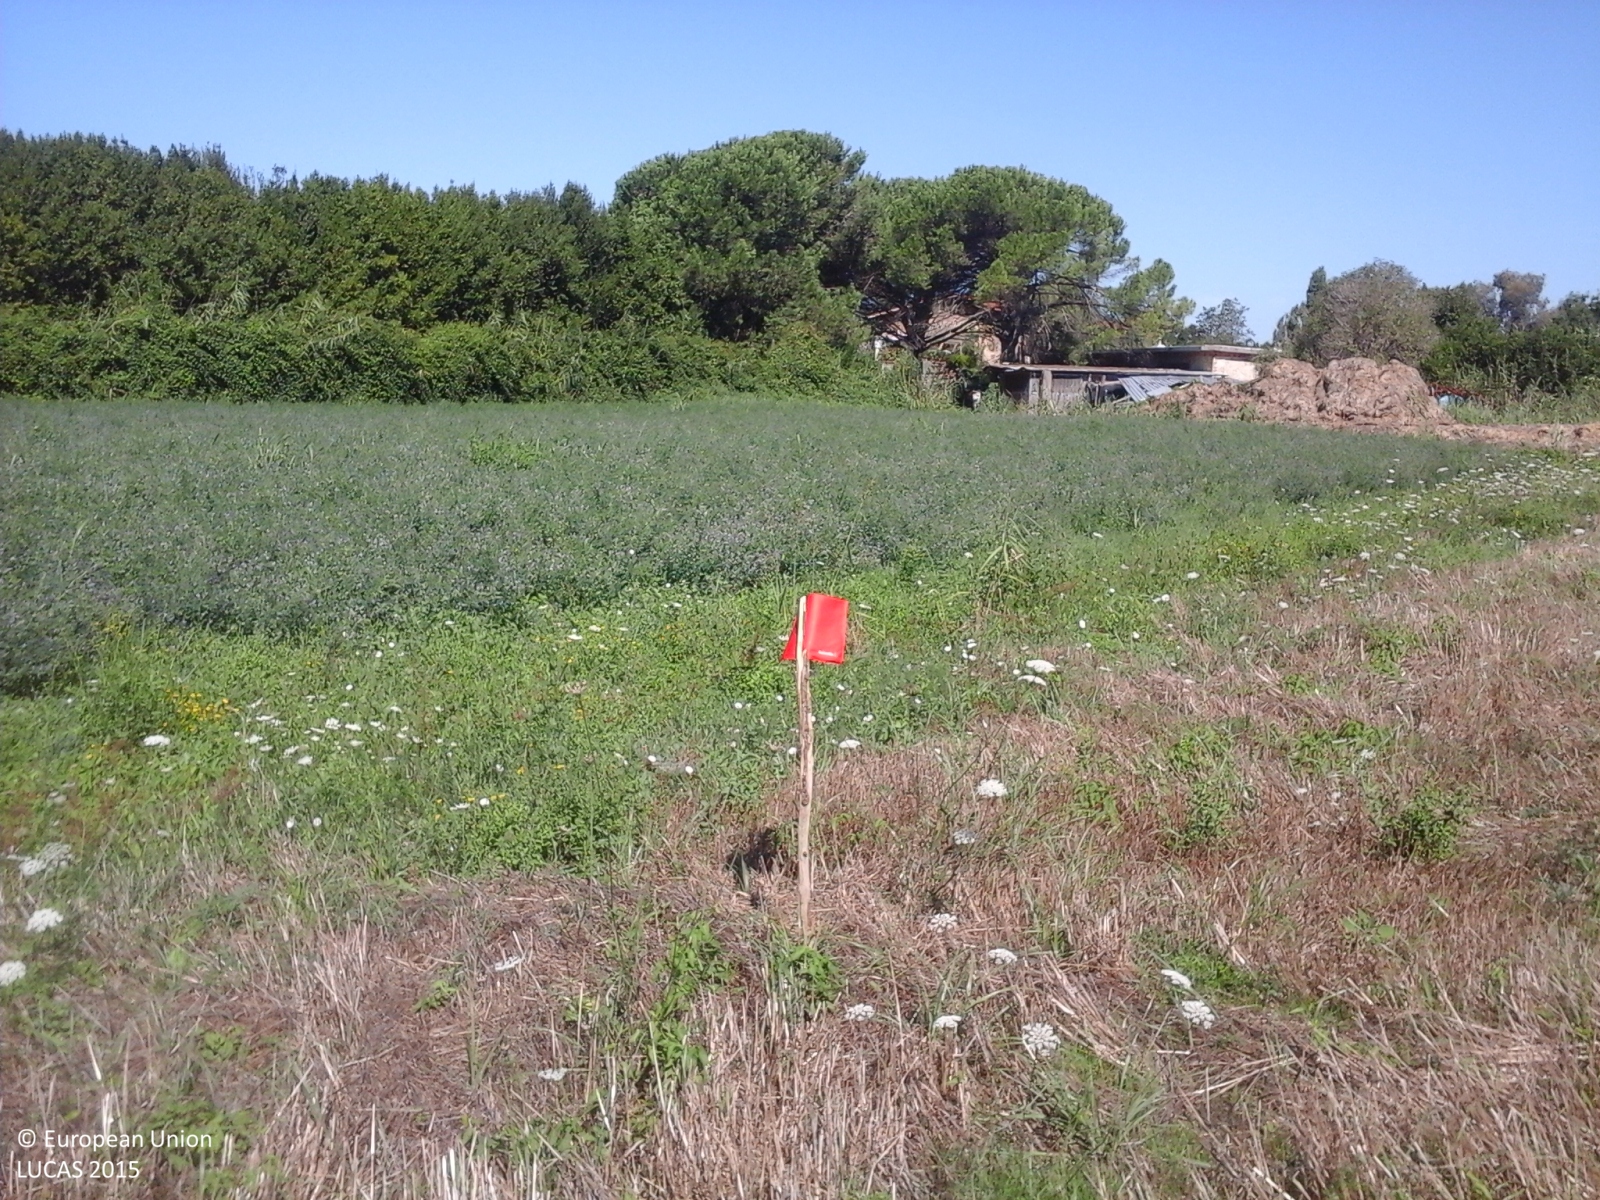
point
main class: Grassland
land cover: Spontaneously vegetated surfaces
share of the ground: > 75 %
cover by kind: herbaceous plants 100 %
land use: Agriculture (excluding fallow land and kitchen gardens)
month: August
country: IT
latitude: 43.7185
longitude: 10.3590
